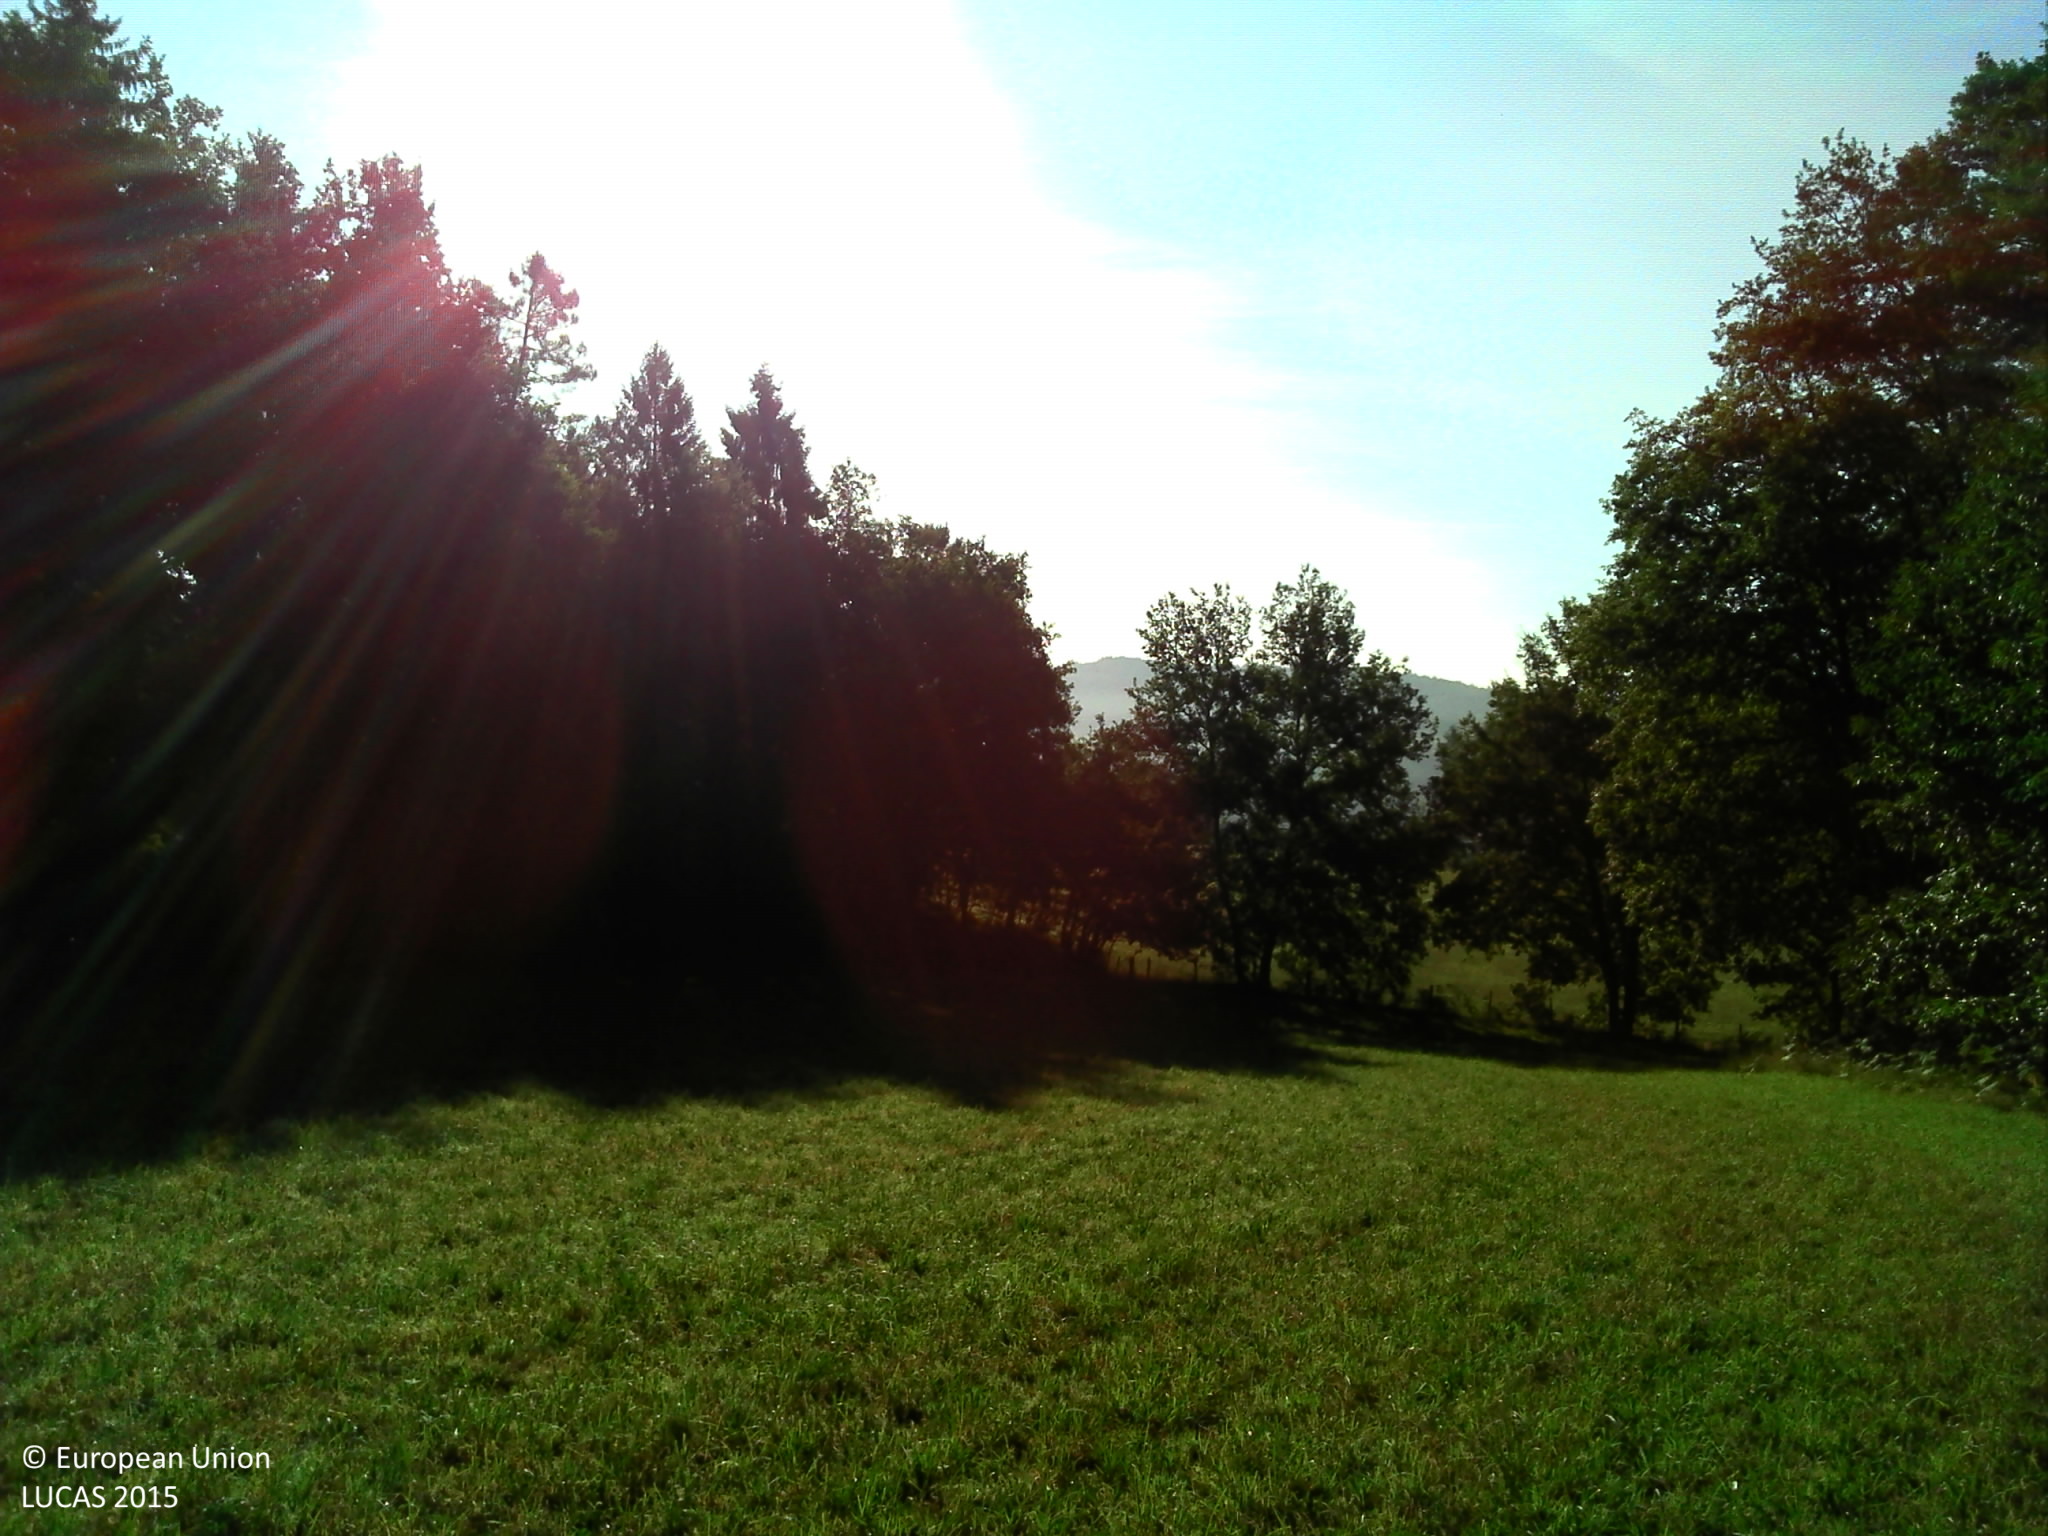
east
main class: Cropland
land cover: Temporary grasslands
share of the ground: > 75 %
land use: Agriculture (excluding fallow land and kitchen gardens)
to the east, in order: Temporary grasslands; Fences; Groves; Tracks; Groves; Grassland without tree/shrub cover
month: July
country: FR
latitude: 45.7289
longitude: 1.8091
